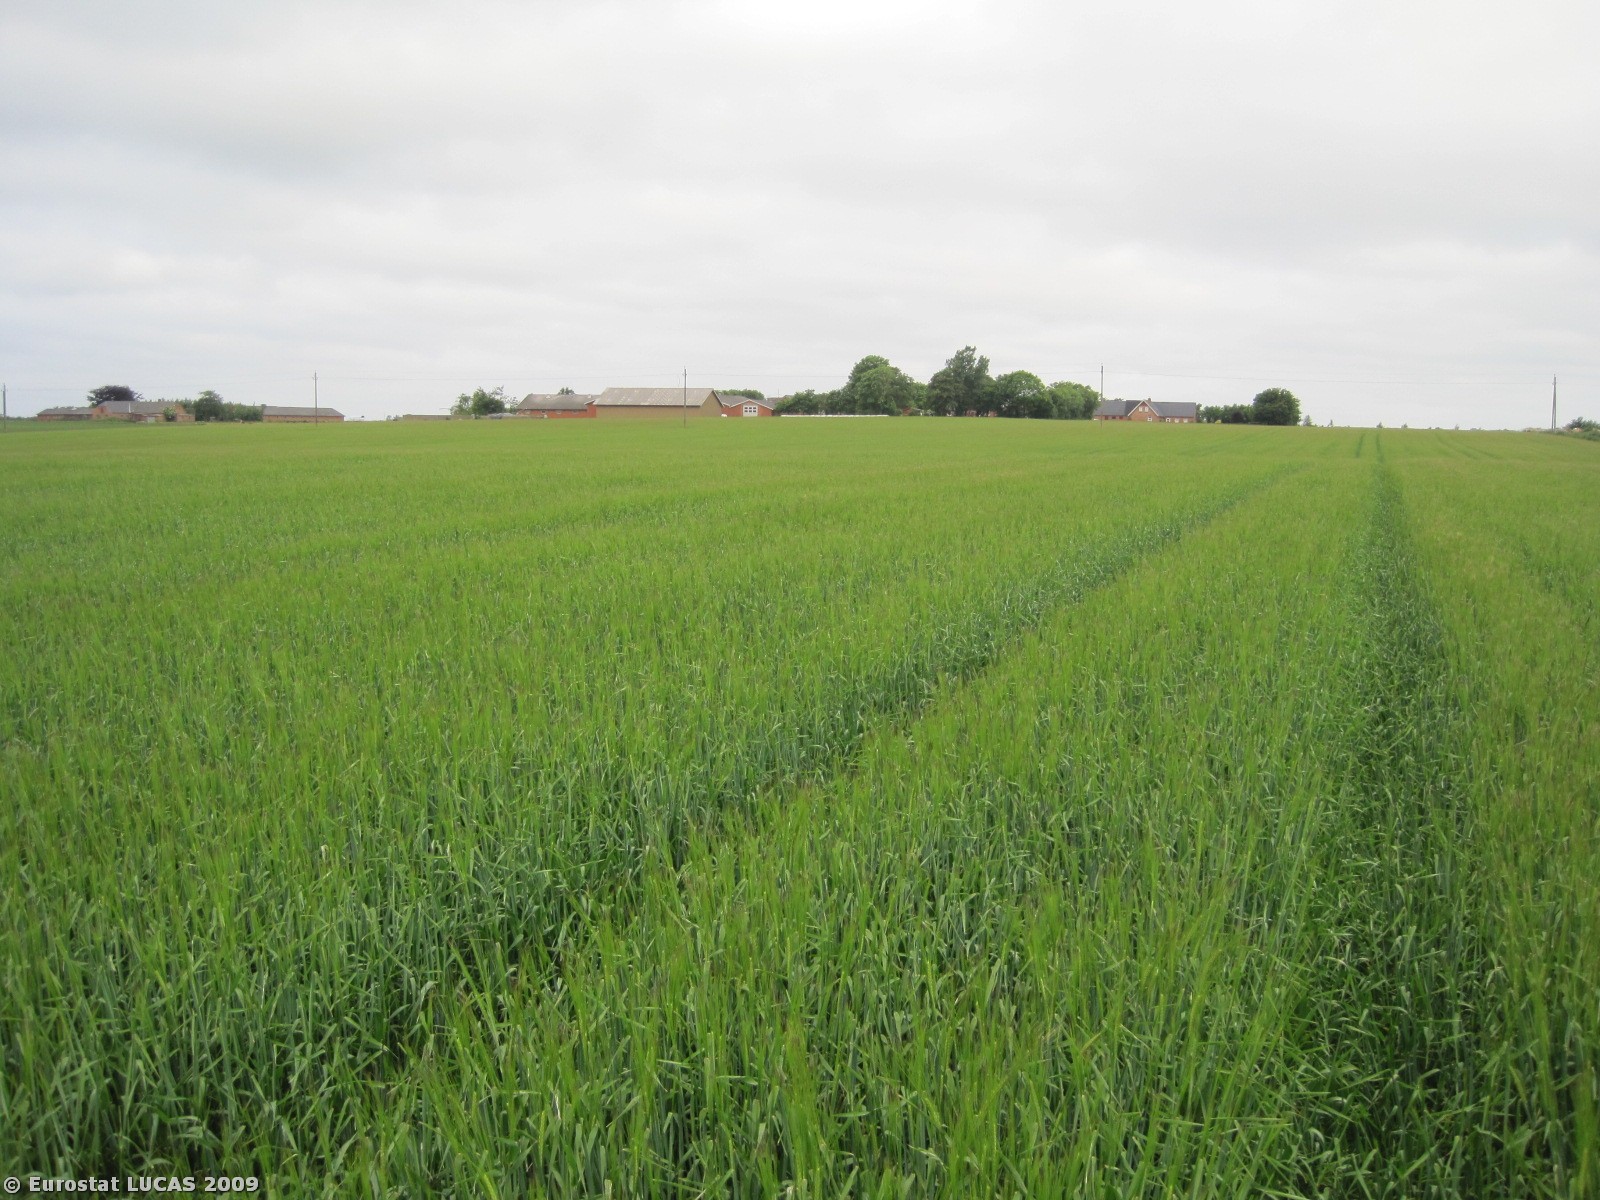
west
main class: Cropland
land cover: Barley
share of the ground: > 75 %
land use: Agriculture (excluding fallow land and kitchen gardens)
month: June
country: DK
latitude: 56.7206
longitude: 8.7108
